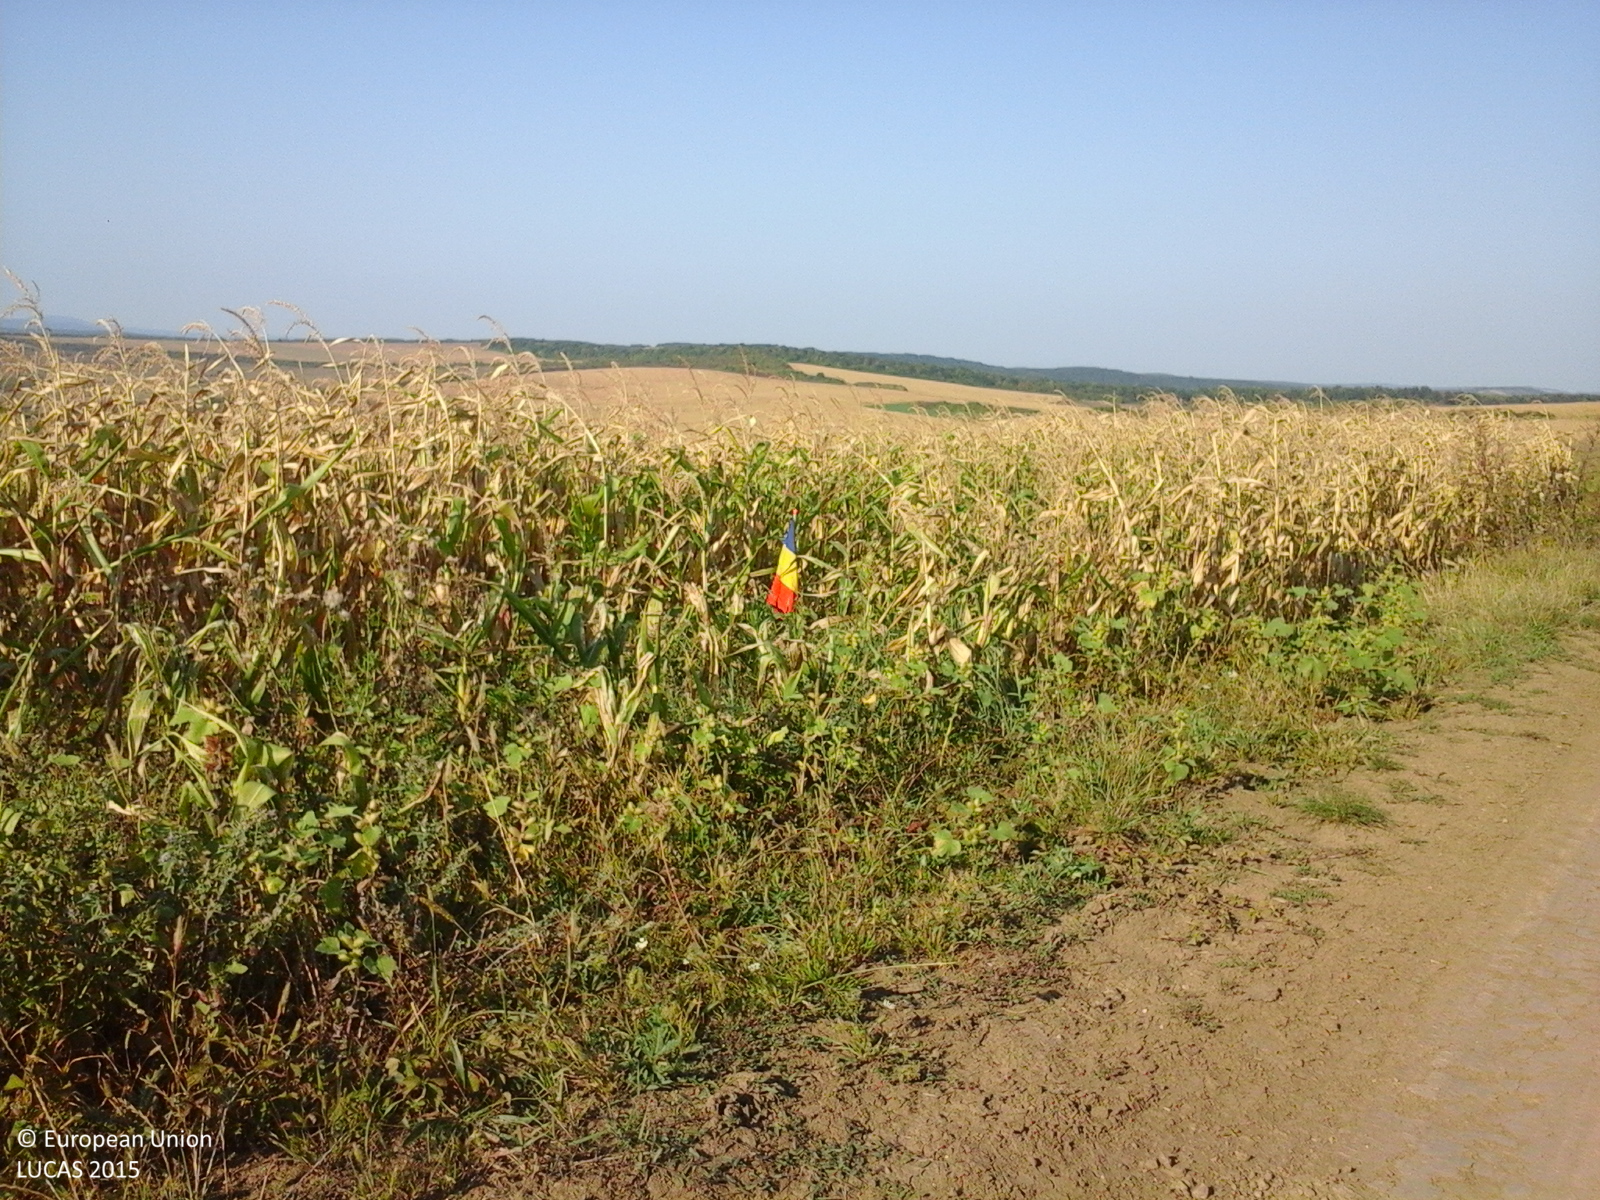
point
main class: Cropland
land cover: Maize
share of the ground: > 75 %
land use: Agriculture (excluding fallow land and kitchen gardens)
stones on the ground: < 10 %
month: September
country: RO
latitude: 47.3347
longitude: 23.0473
